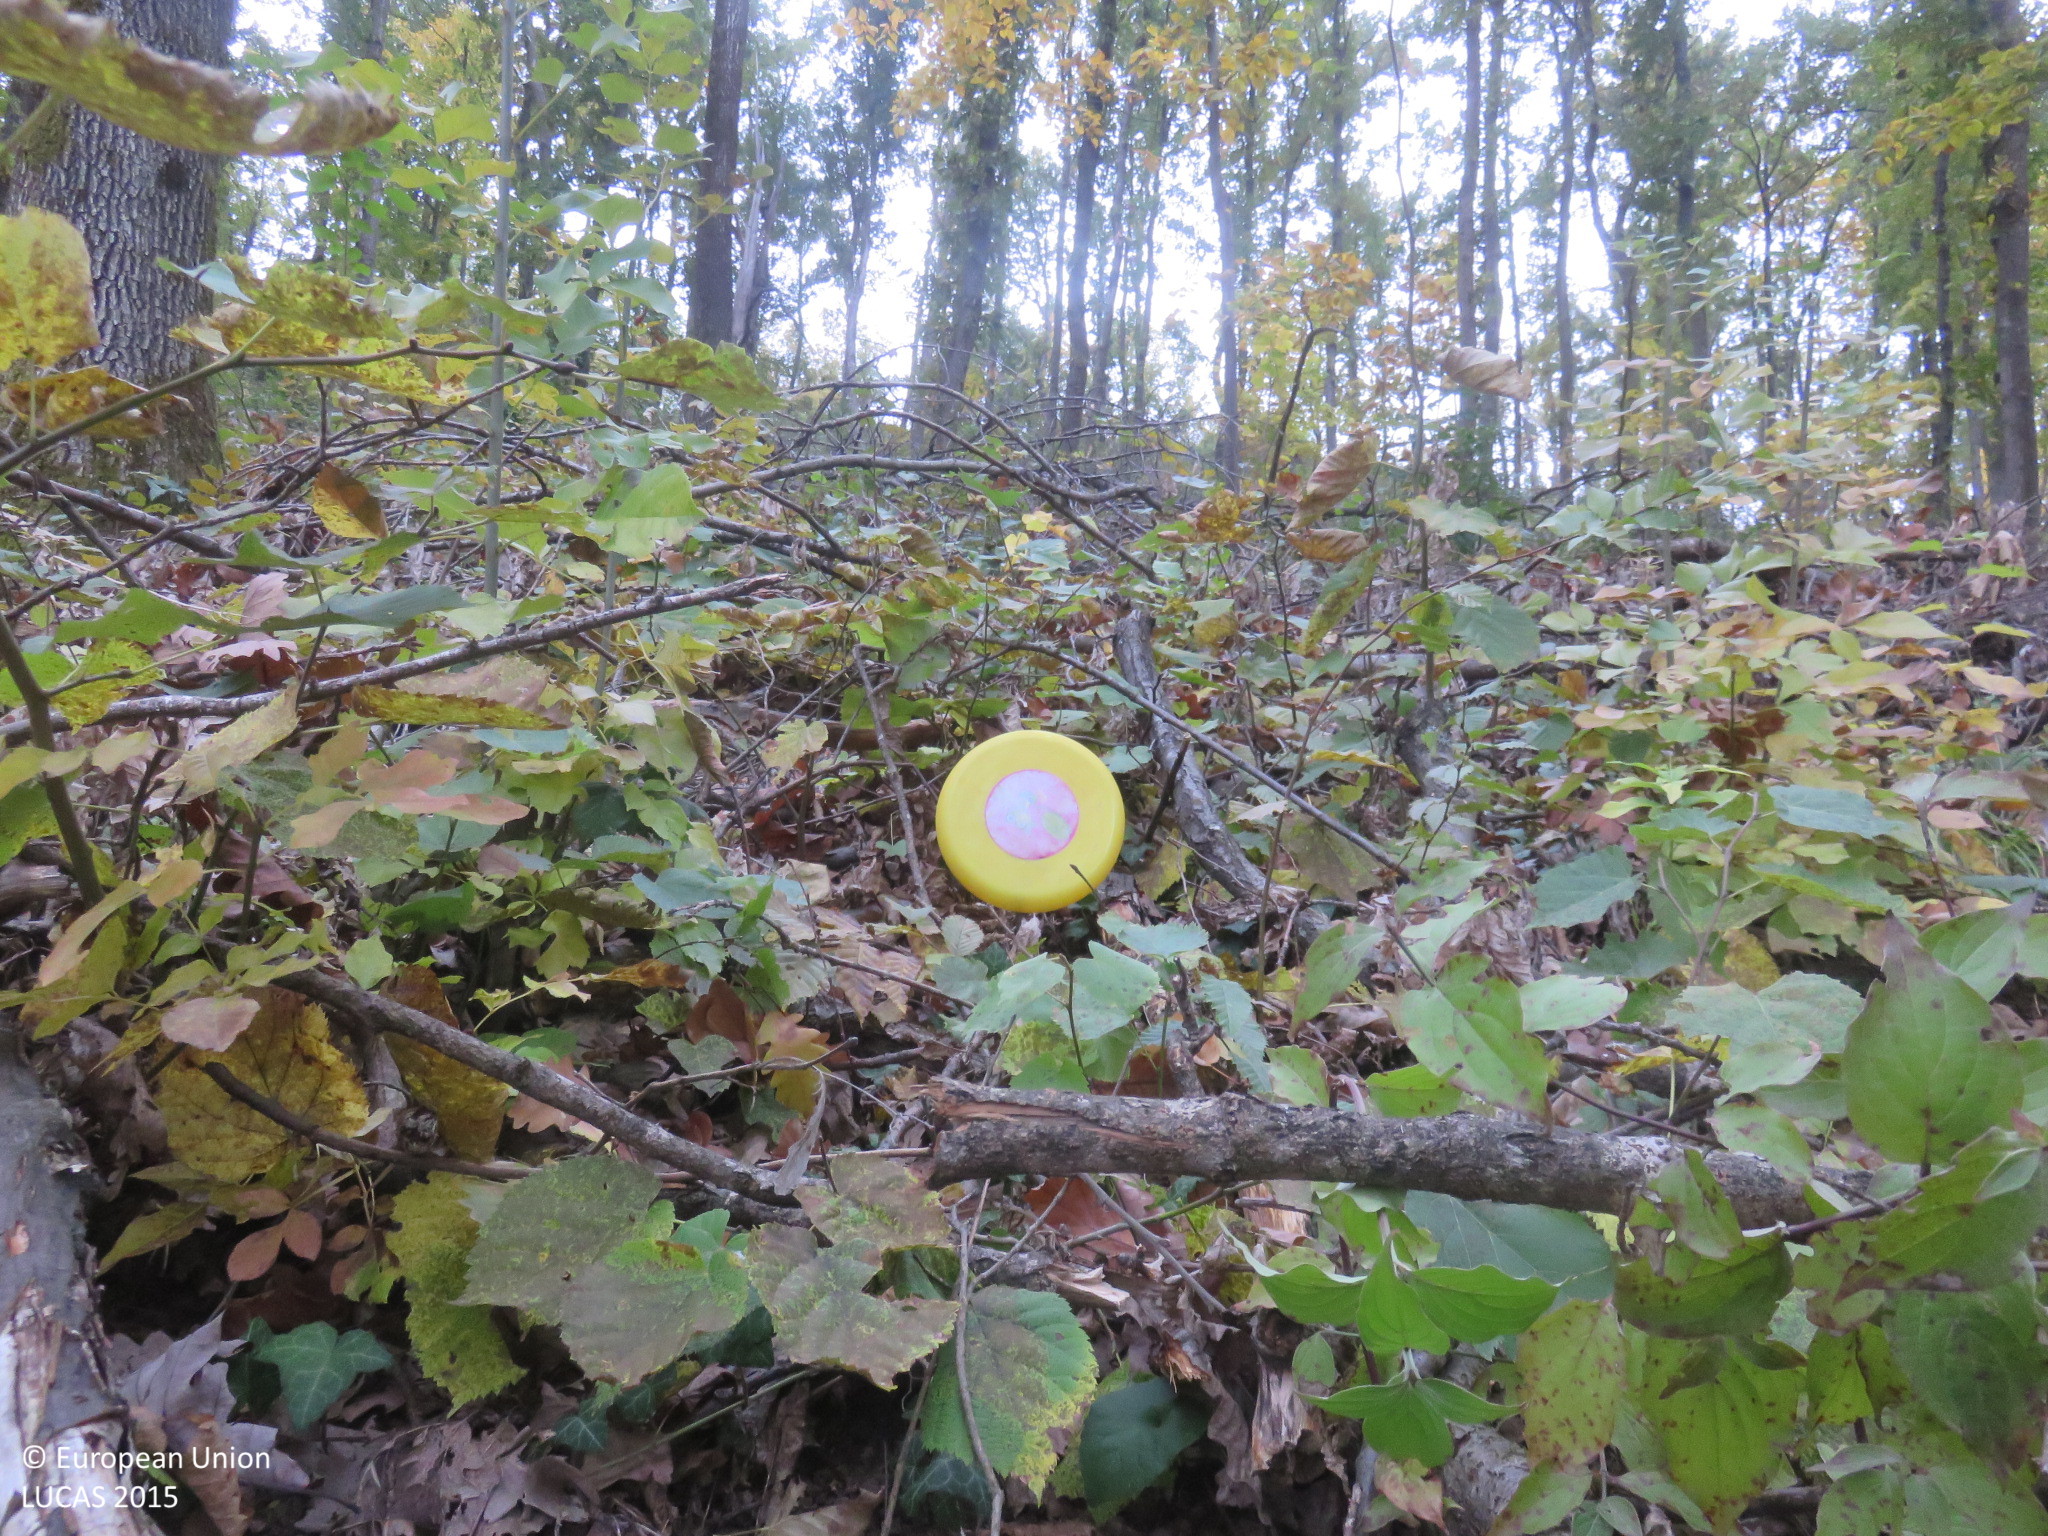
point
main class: Woodland
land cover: Broadleaved woodland
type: mesophytic deciduous forest
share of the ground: > 75 %
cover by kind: broadleaved forest trees 80 %, shrubs 10 %, herbaceous plants 10 %
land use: Forestry
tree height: > 5 m
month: October
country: BG
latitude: 42.9443
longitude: 24.9800
